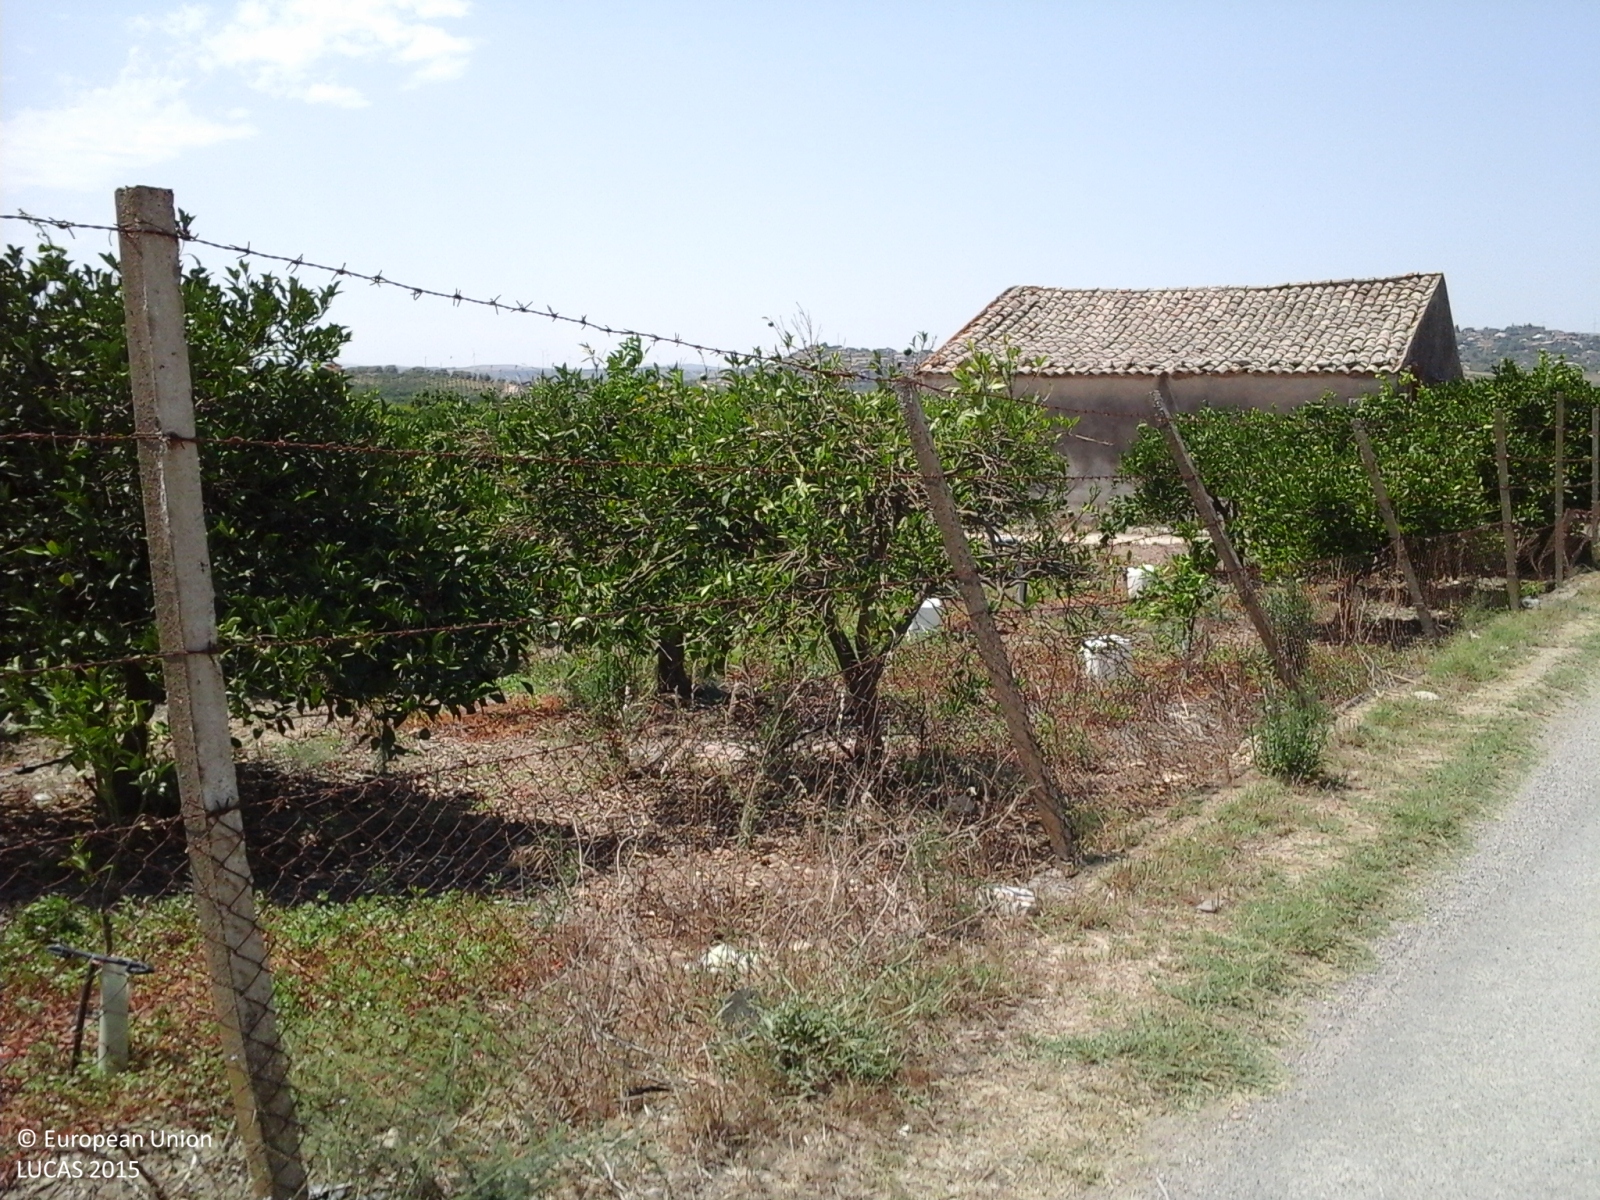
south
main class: Cropland
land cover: Oranges
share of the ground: > 75 %
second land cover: Spontaneously vegetated surfaces
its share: > 75 %
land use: Agriculture (excluding fallow land and kitchen gardens)
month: August
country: IT
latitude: 37.3146
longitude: 14.8497
